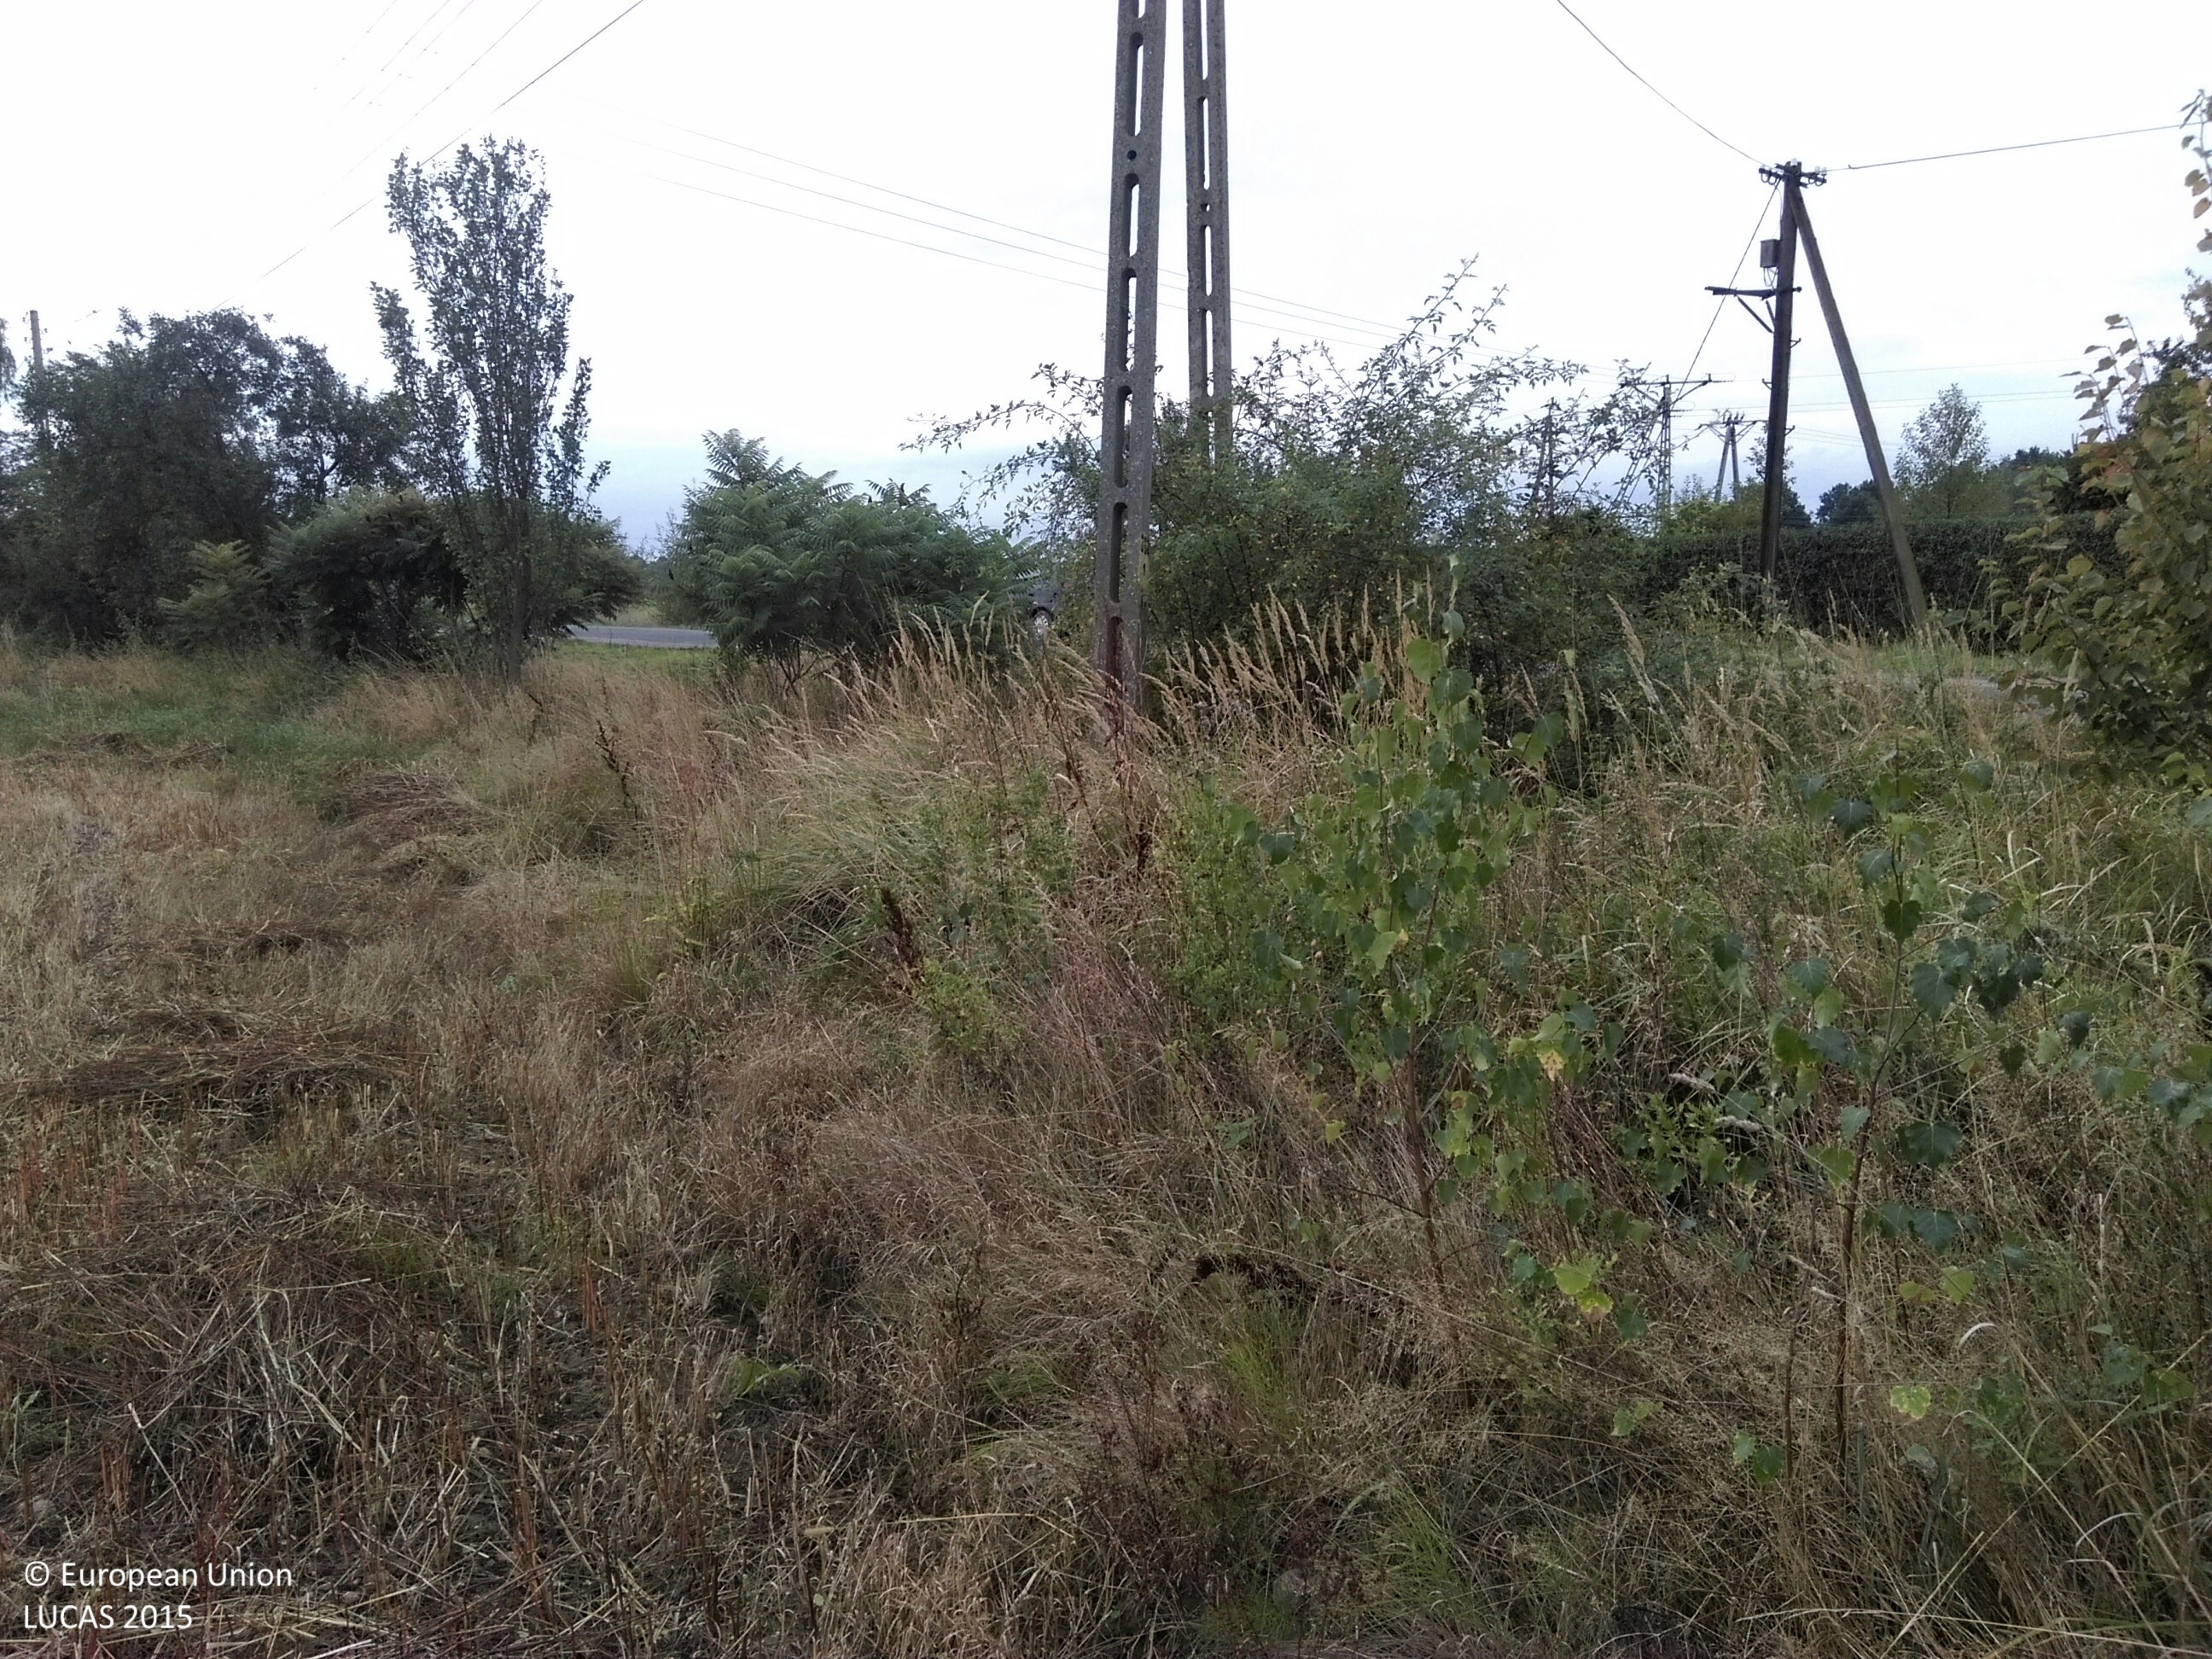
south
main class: Cropland
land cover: Temporary grasslands
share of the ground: > 75 %
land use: Agriculture (excluding fallow land and kitchen gardens)
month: September
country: PL
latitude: 51.6356
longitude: 15.5381
